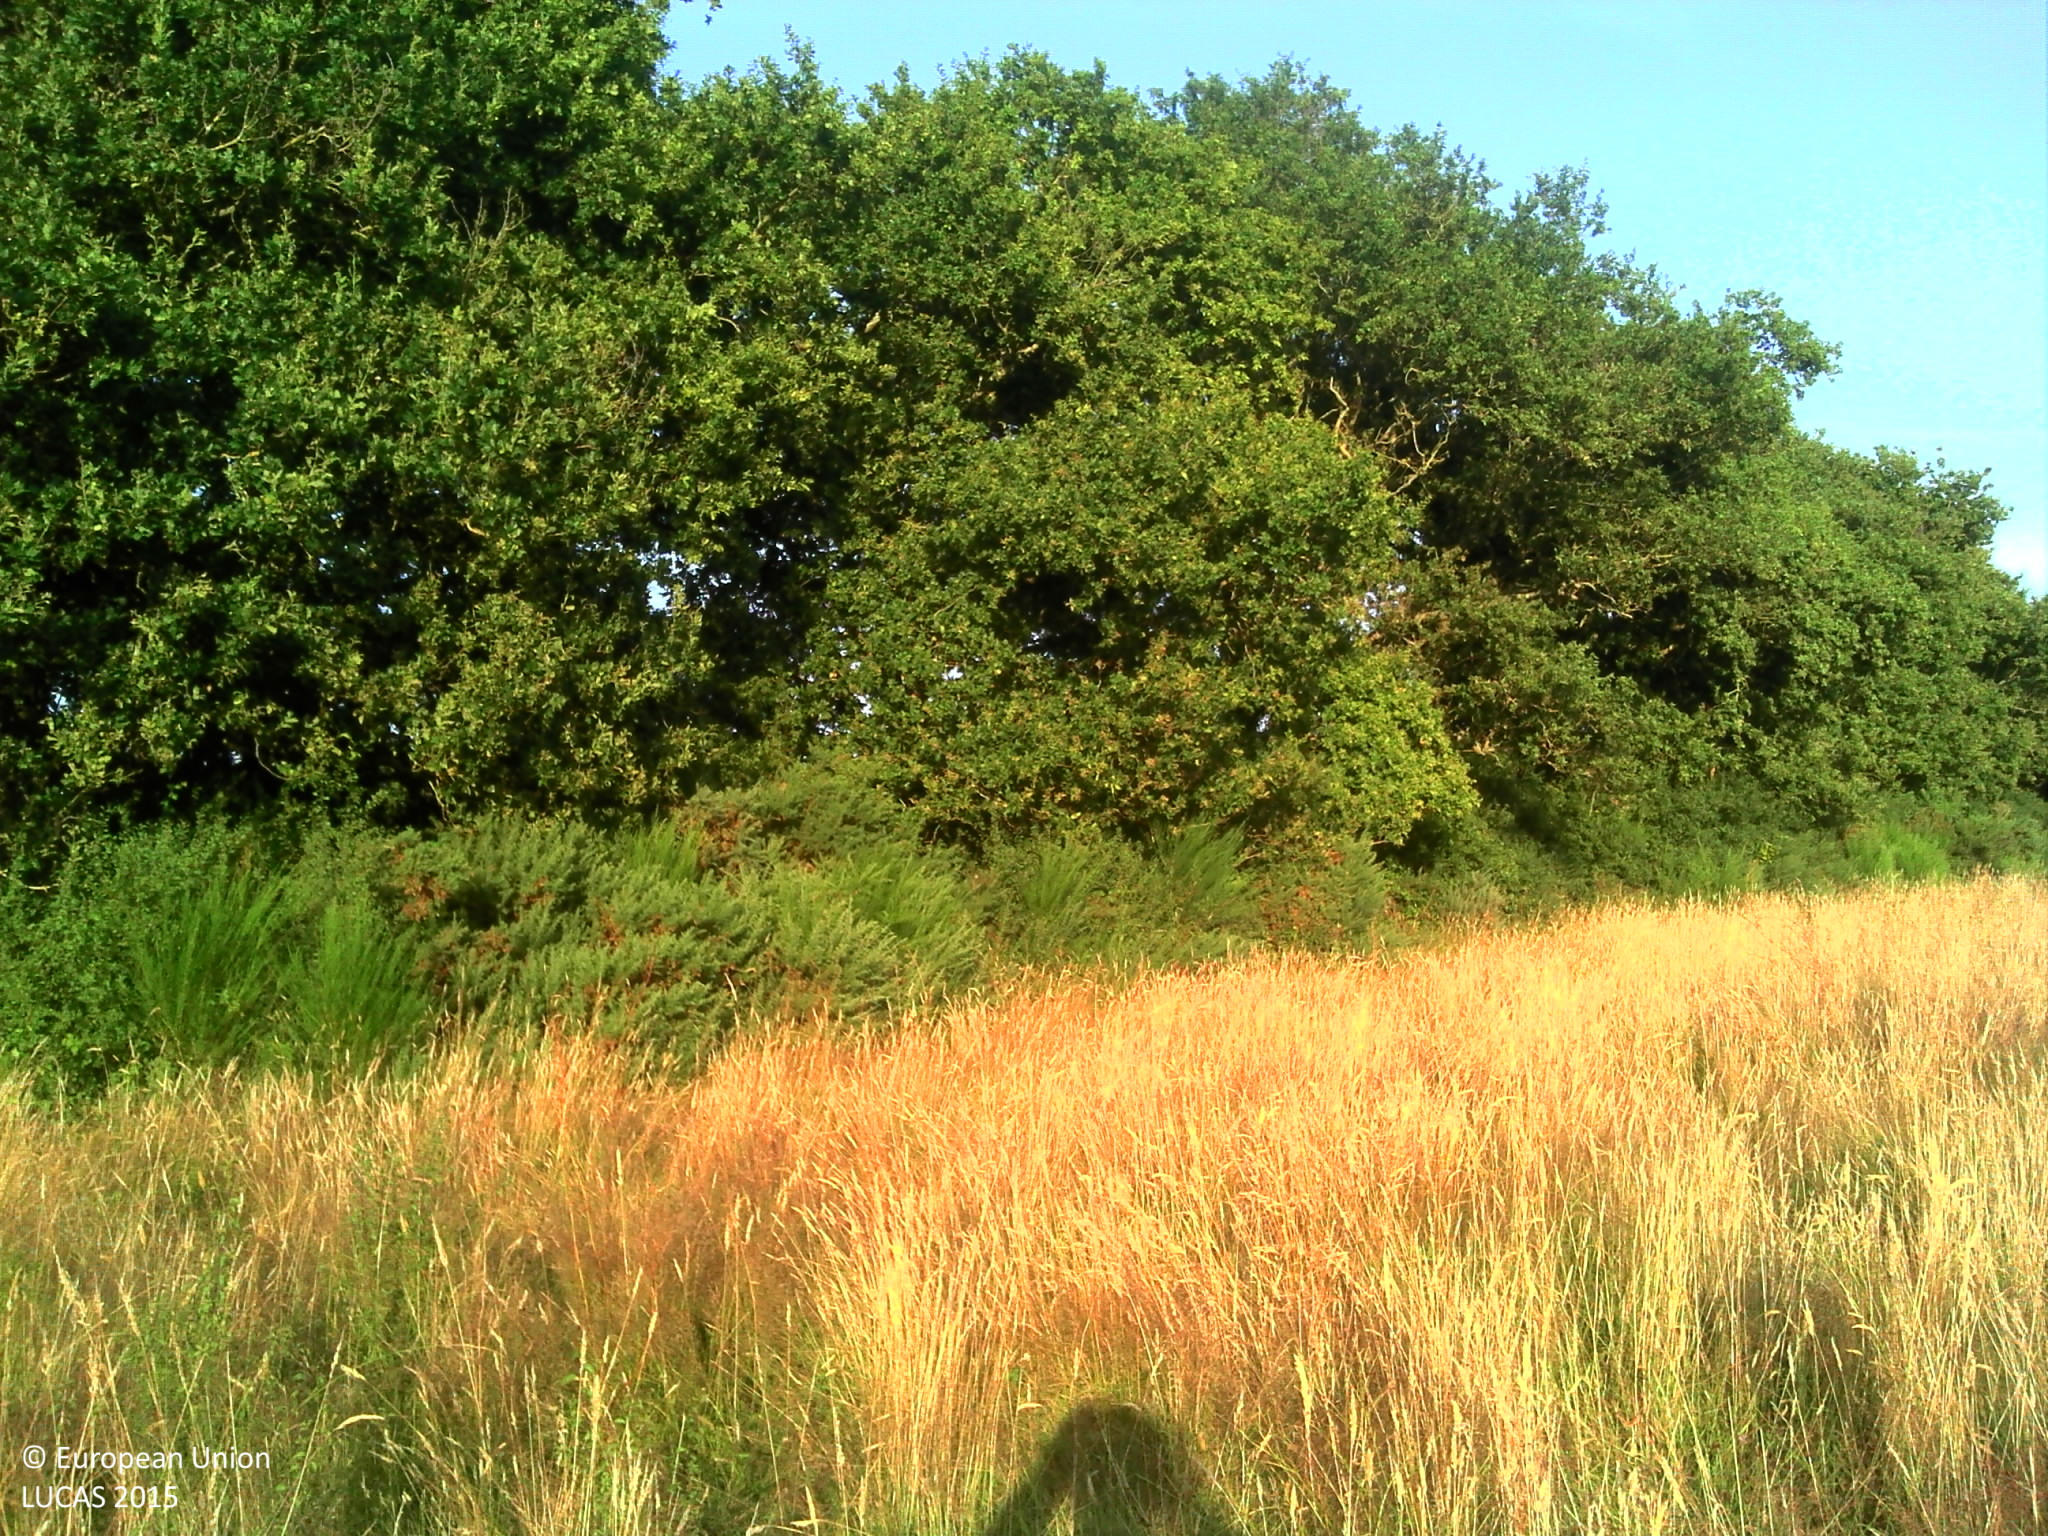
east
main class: Grassland
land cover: Grassland without tree/shrub cover
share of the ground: > 75 %
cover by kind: herbaceous plants 100 %
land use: Agriculture (excluding fallow land and kitchen gardens)
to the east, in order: Grassland without tree/shrub cover; Ditches and canals; Broadleaved woodland; Common wheat; Broadleaved woodland; Ditches and canals; Paved roads, cycling and walking lanes; Grass margins; Ditches and canals; Broadleaved woodland; Maize
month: July
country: FR
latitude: 46.4674
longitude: -1.5633
